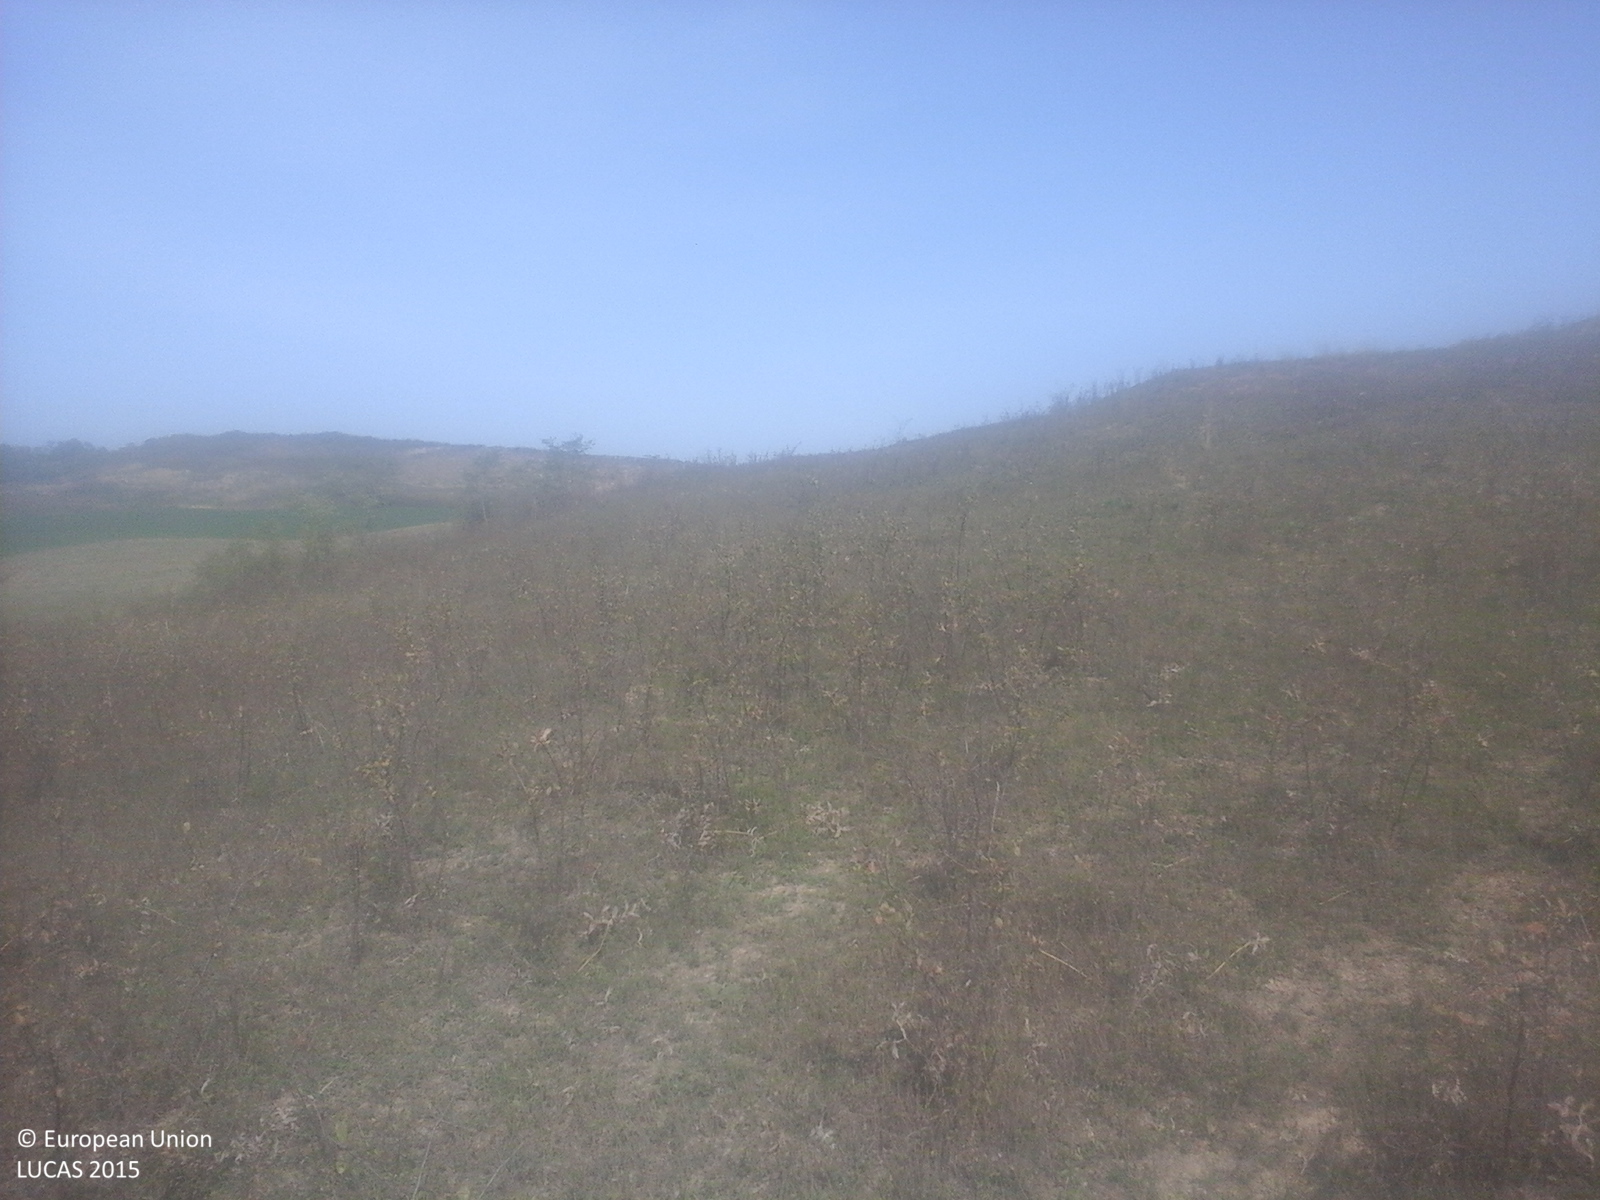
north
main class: Grassland
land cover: Spontaneously vegetated surfaces
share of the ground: > 75 %
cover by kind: herbaceous plants 100 %
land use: Agriculture (excluding fallow land and kitchen gardens)
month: September
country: RO
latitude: 46.8835
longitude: 24.2971
